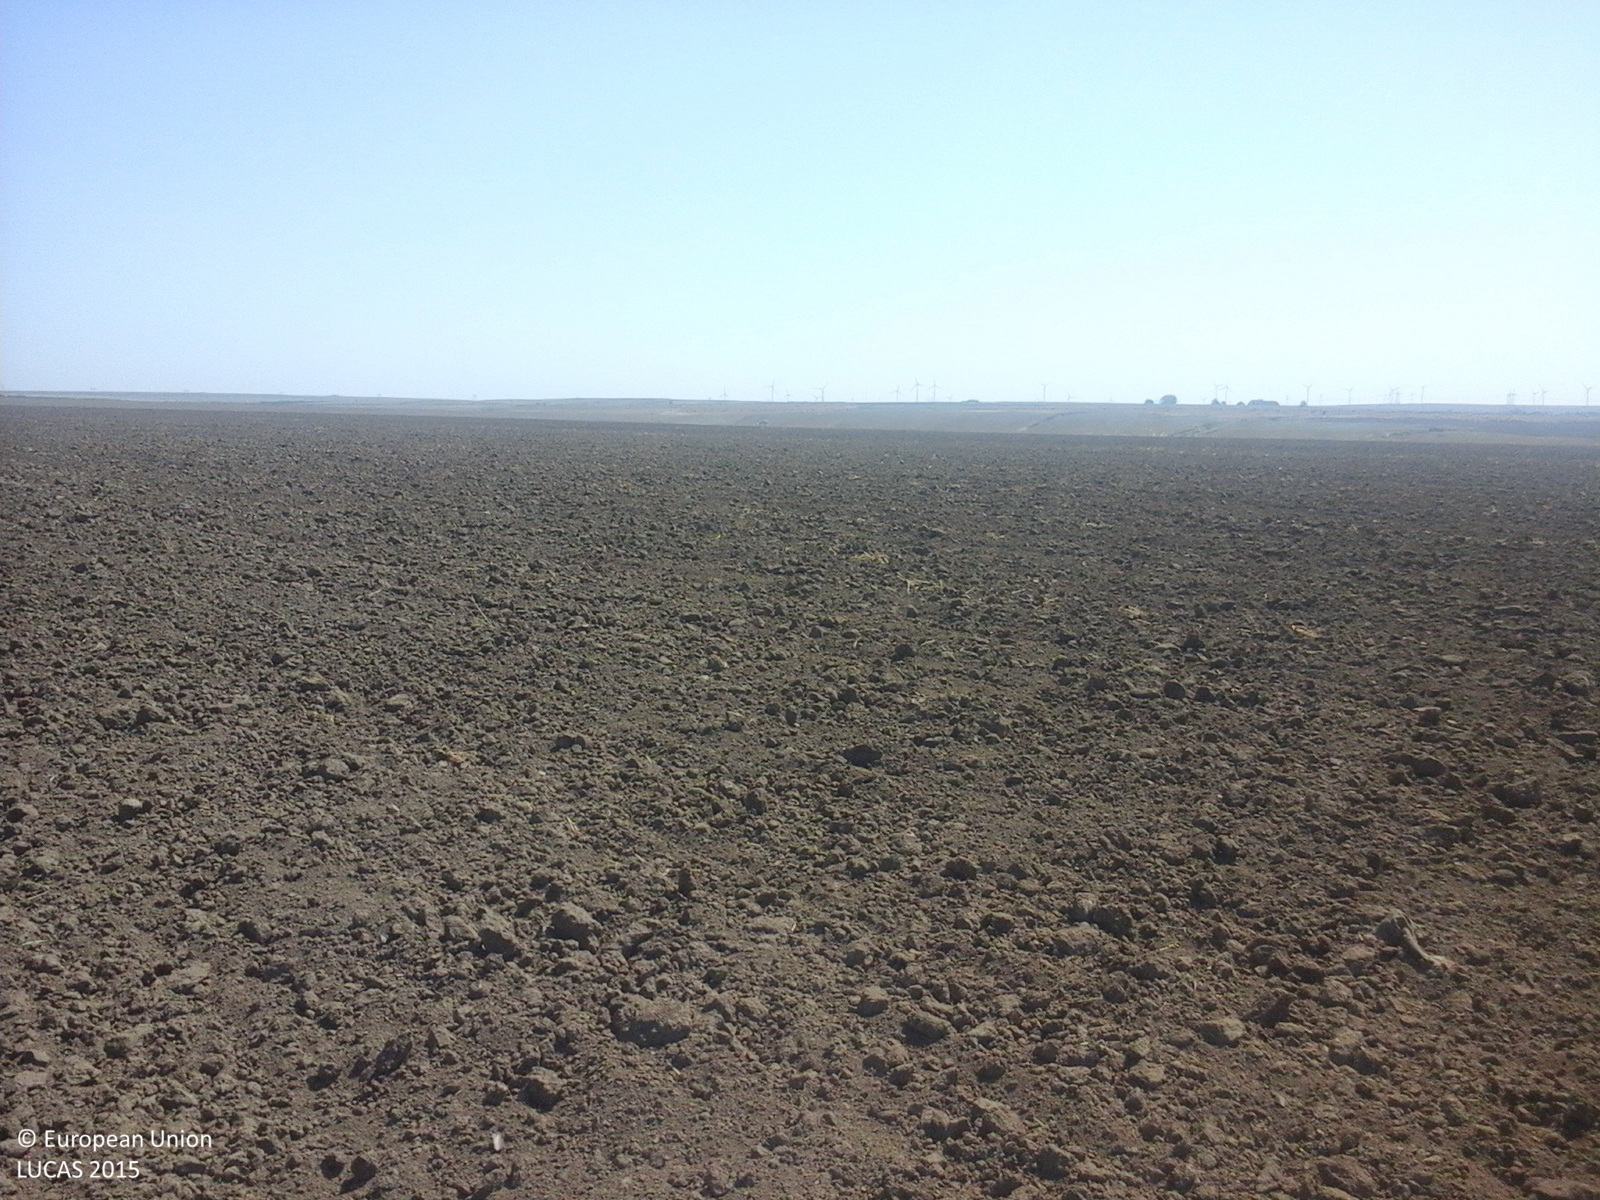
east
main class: Cropland
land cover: Barley
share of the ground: < 10 %
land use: Agriculture (excluding fallow land and kitchen gardens)
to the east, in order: Barley
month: August
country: RO
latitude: 44.6159
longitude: 28.1468
